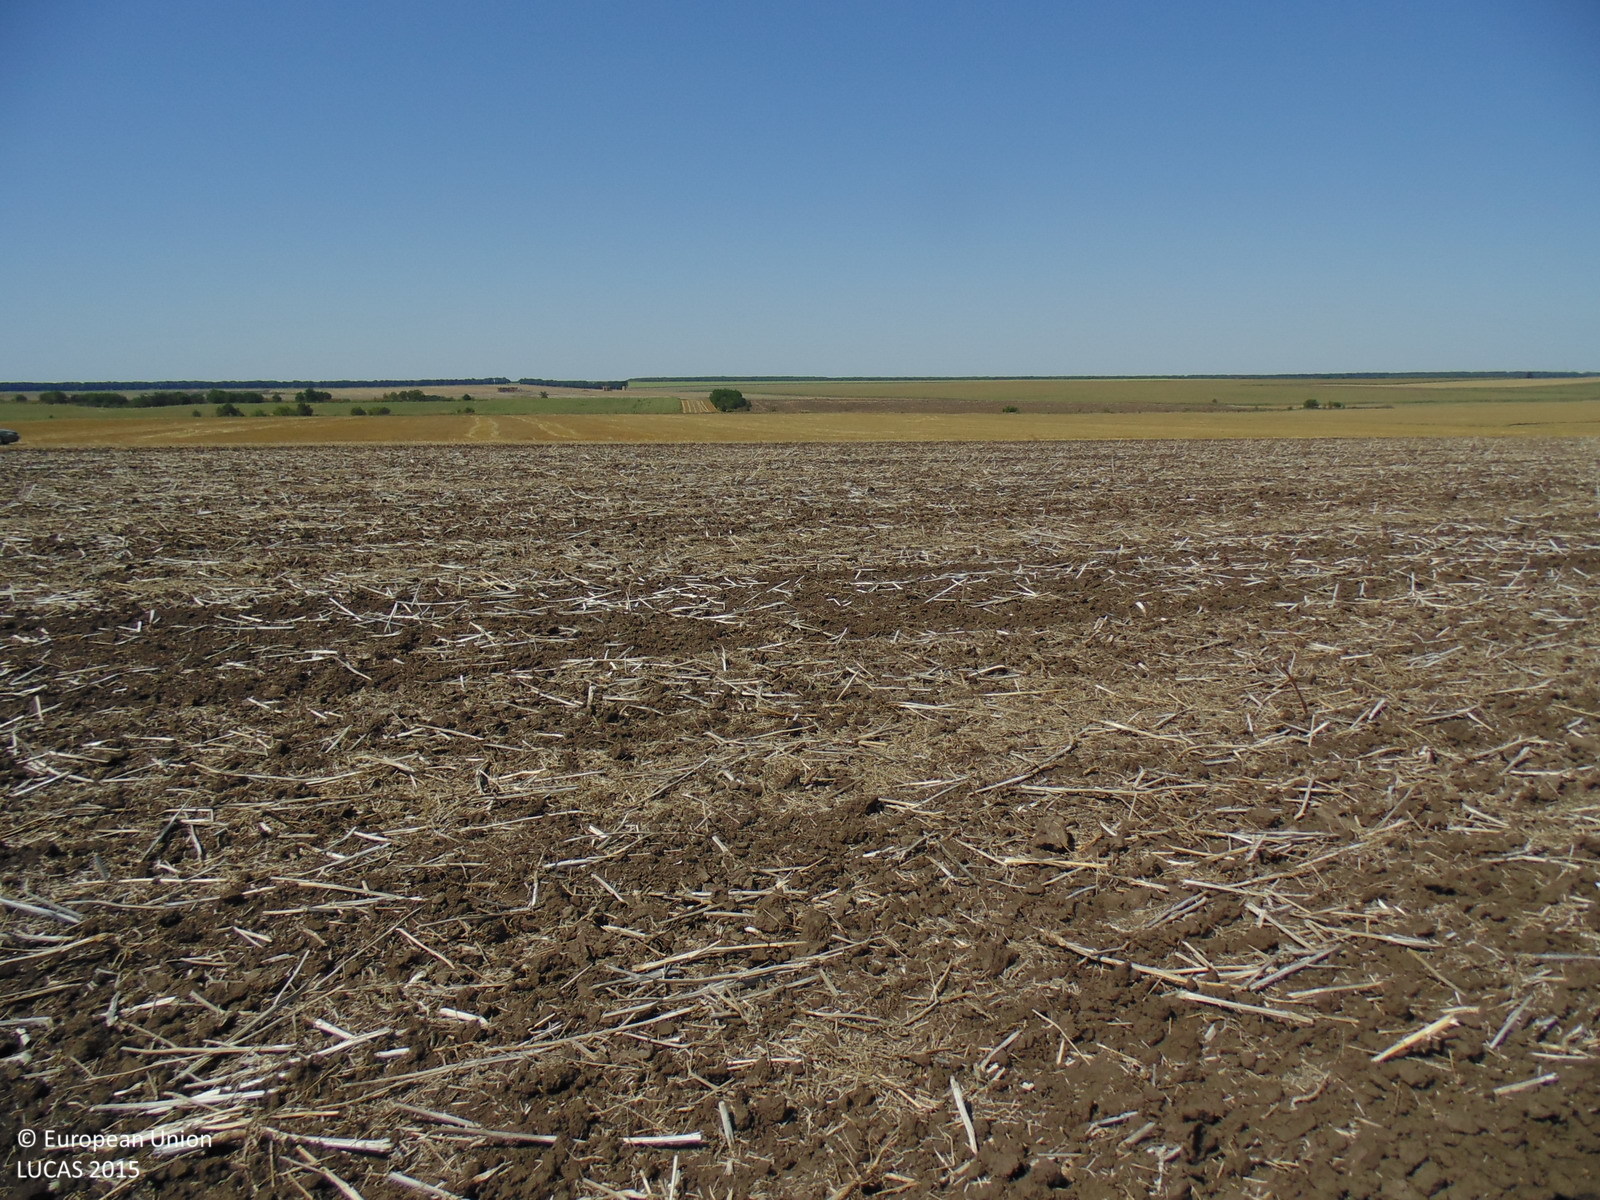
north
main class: Cropland
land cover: Rape and turnip rape
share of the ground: < 10 %
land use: Agriculture (excluding fallow land and kitchen gardens)
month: August
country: BG
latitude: 43.5350
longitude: 28.2069
